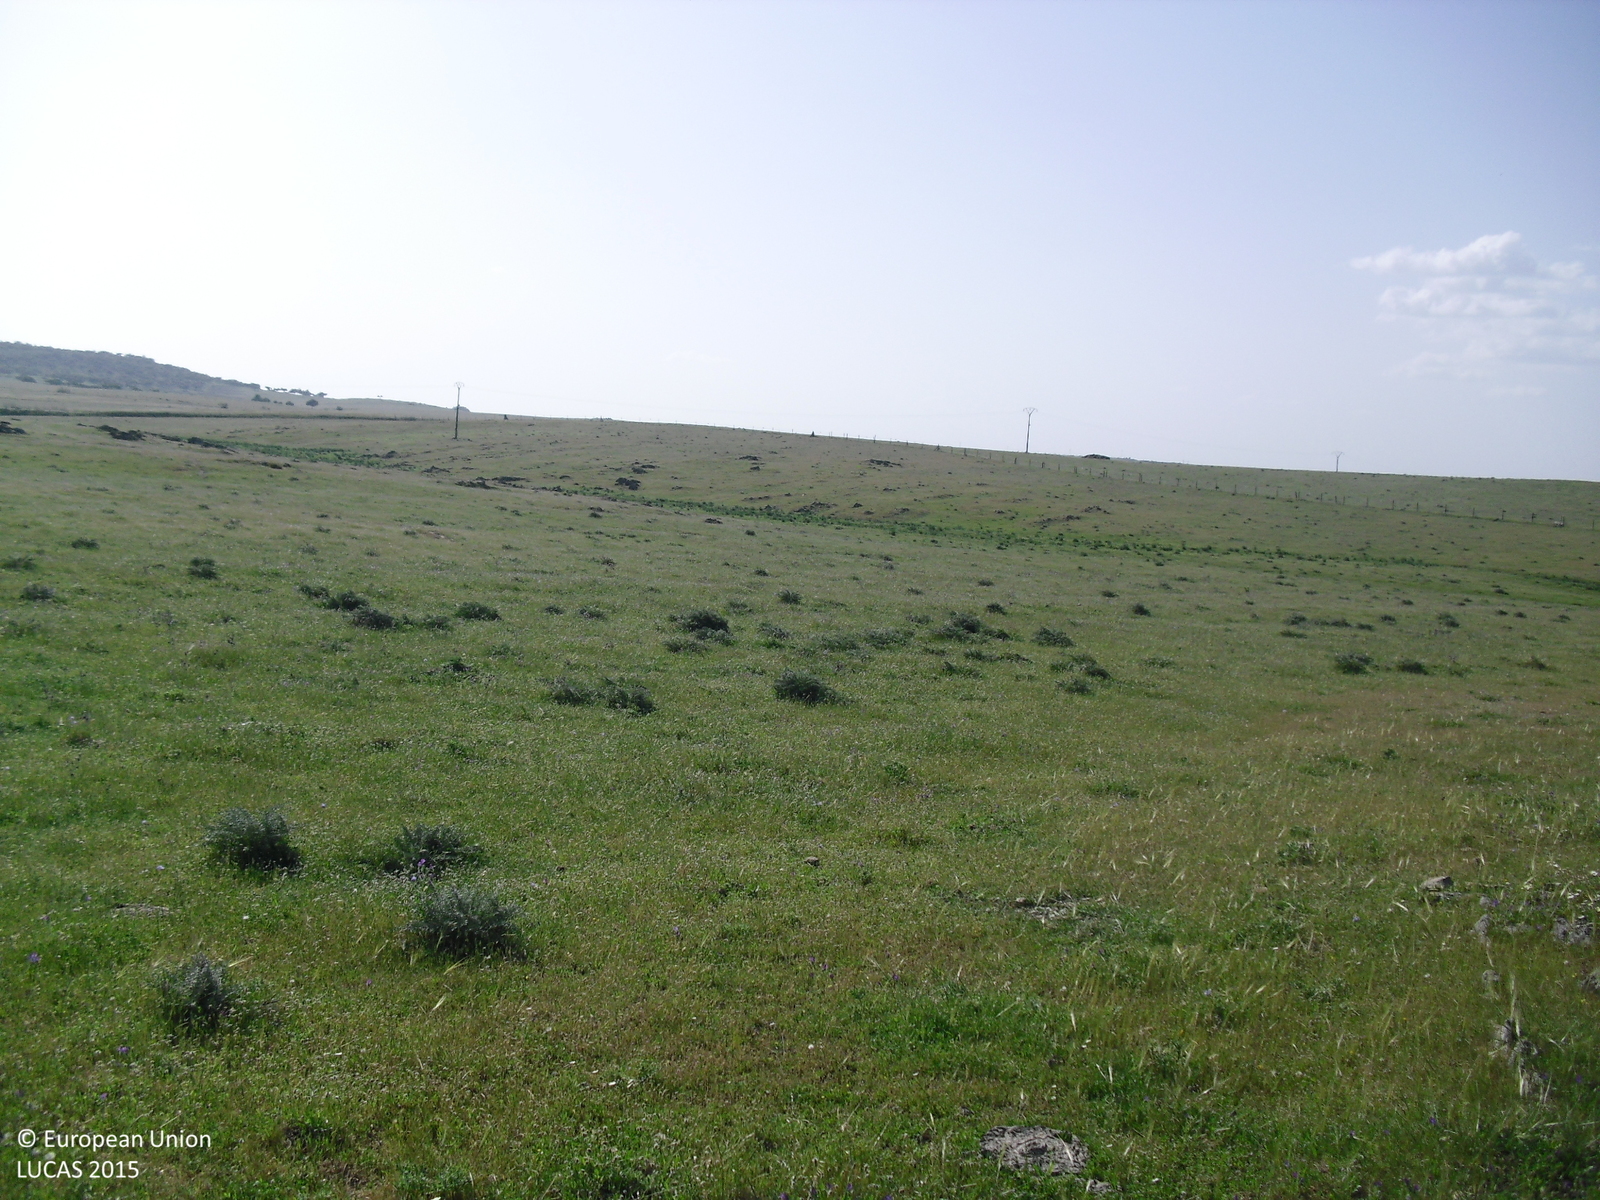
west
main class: Grassland
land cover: Grassland without tree/shrub cover
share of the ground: > 75 %
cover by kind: herbaceous plants 100 %
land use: Agriculture (excluding fallow land and kitchen gardens)
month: April
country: ES
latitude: 39.5054
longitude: -6.3854
